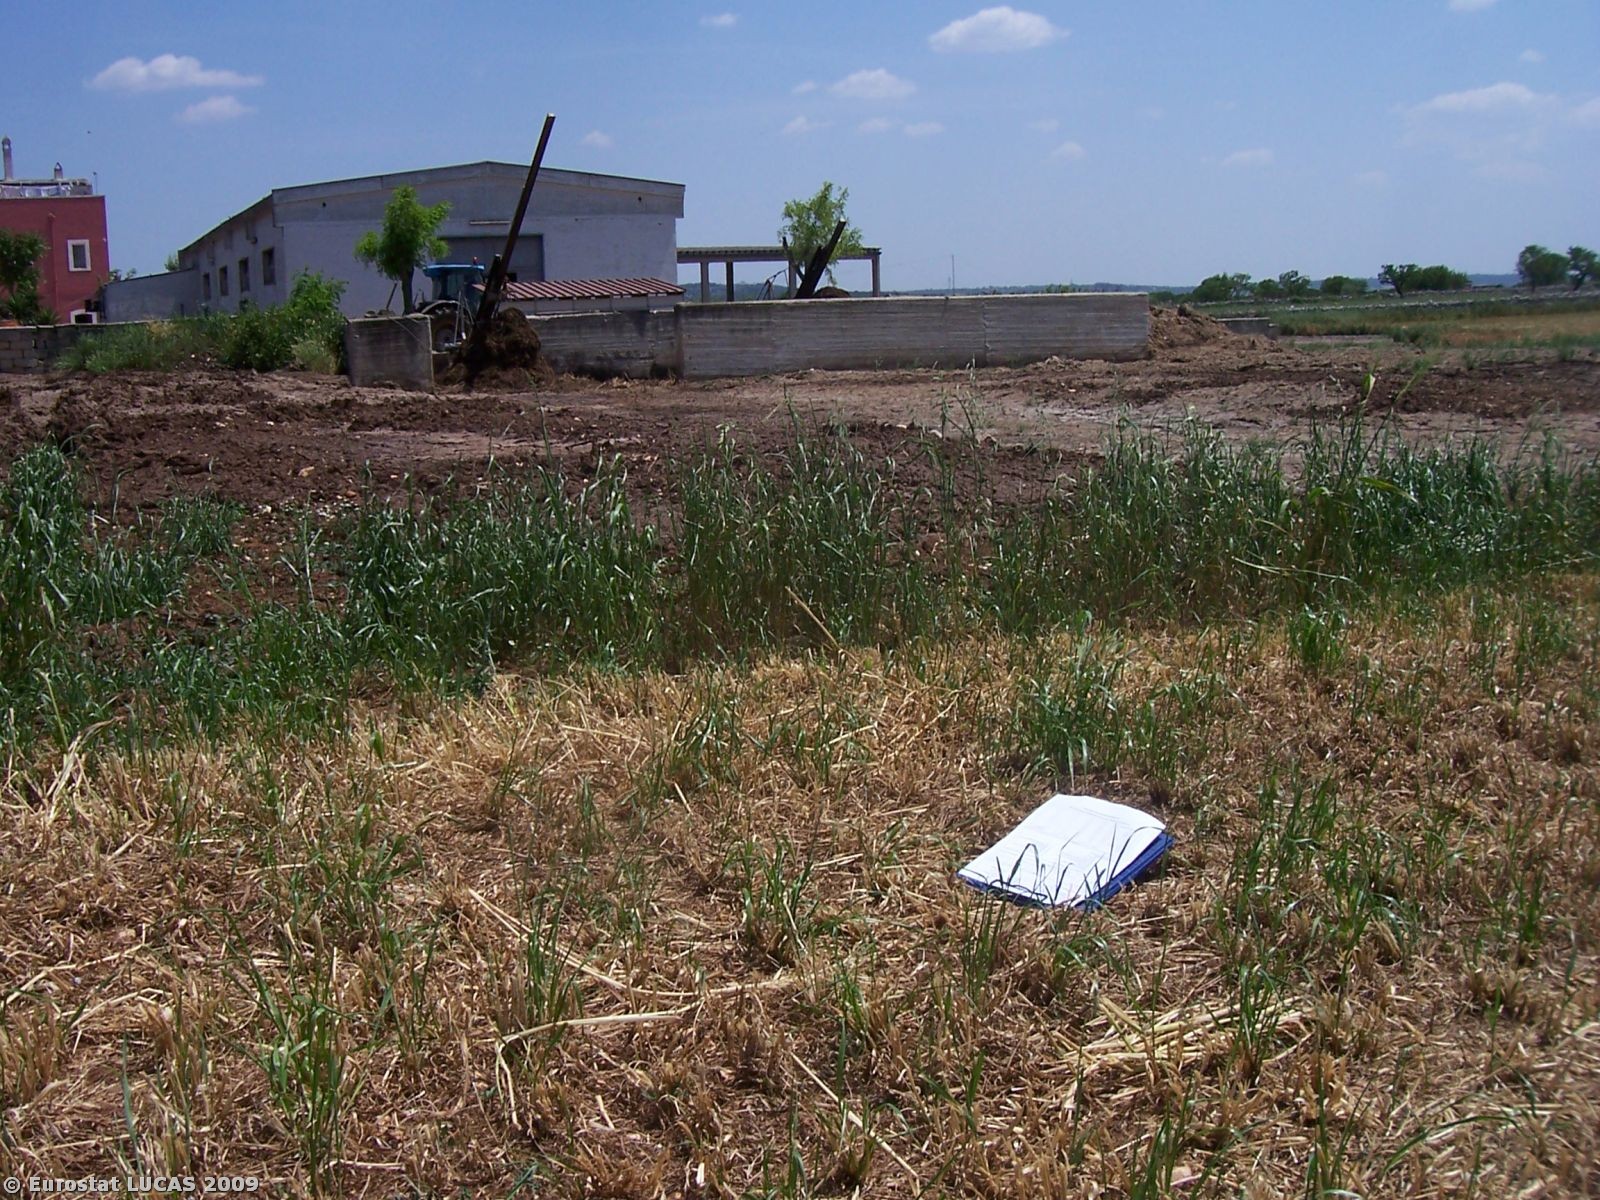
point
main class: Cropland
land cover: Other leguminous and mixtures for fodder
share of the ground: < 10 %
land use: Agriculture (excluding fallow land and kitchen gardens)
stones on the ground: < 10 %
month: May
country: IT
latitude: 40.7449
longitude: 16.9764
